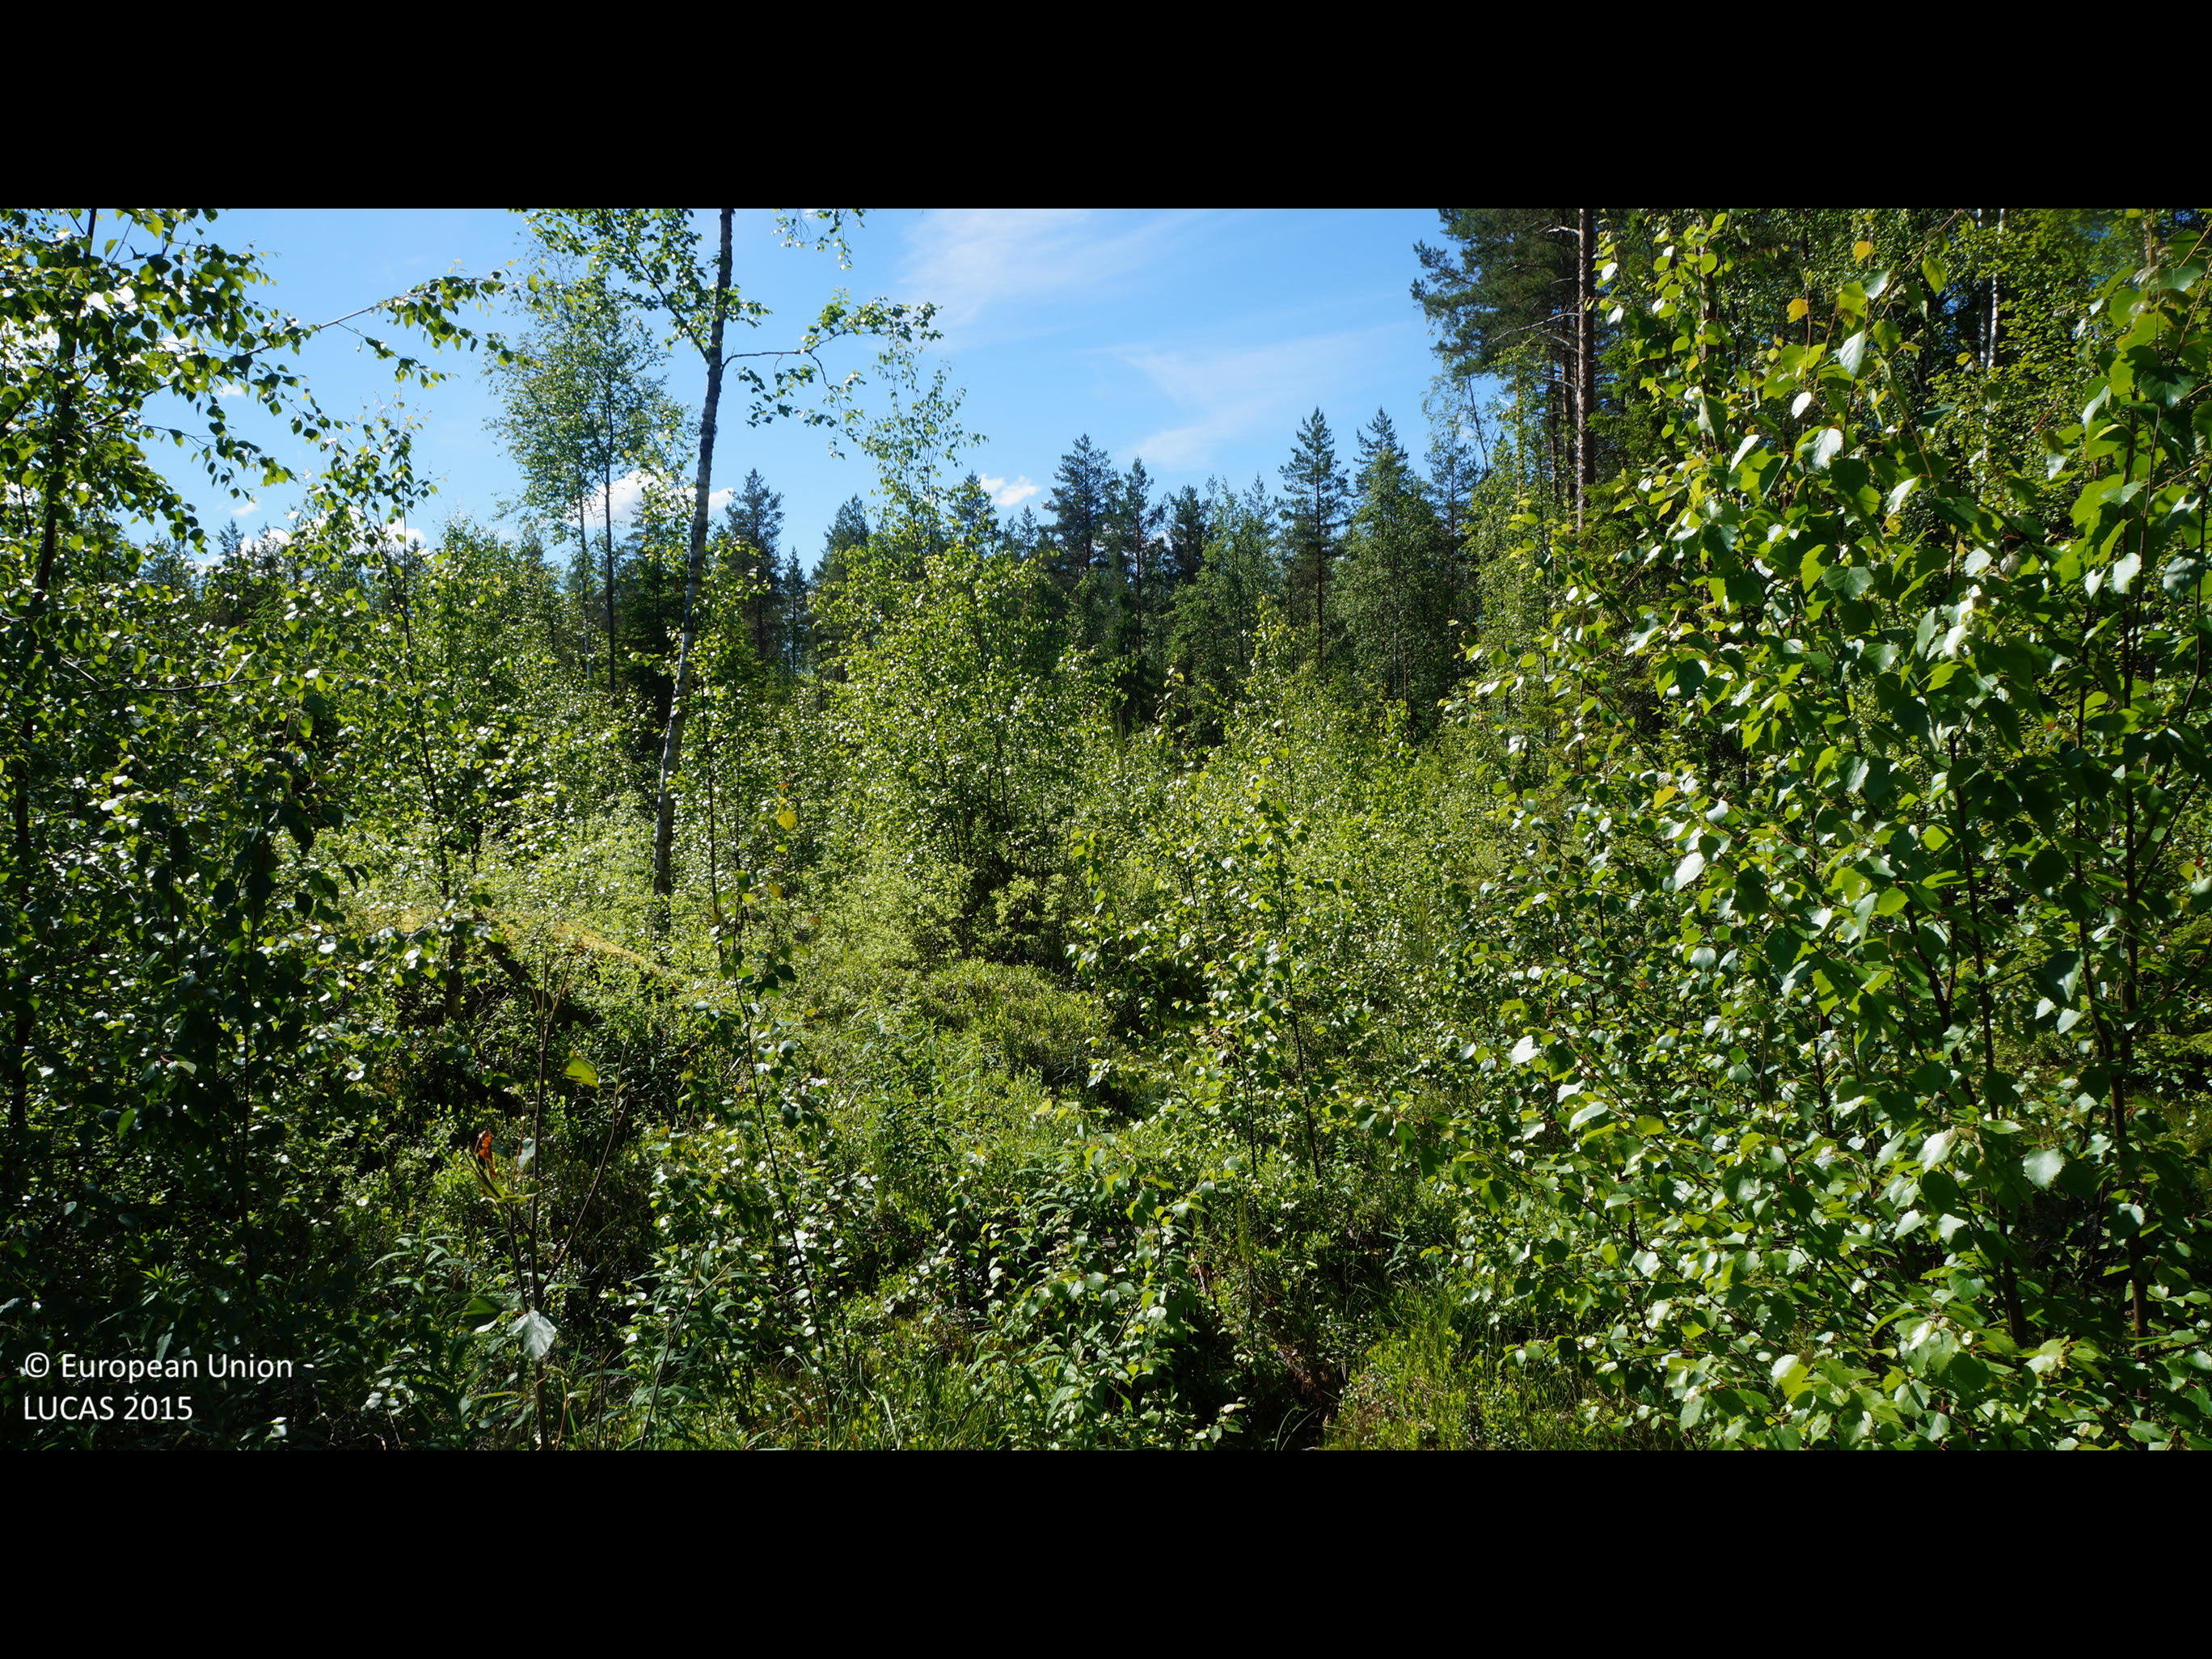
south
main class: Woodland
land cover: Broadleaved woodland
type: boreal forest
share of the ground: 50 - 75 %
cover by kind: broadleaved forest trees 40 %, shrubs 40 %, coniferous forest trees 10 %, herbaceous plants 5 %, unconsolidated bare surface 5 %
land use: Forestry
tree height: < 5 m
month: July
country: FI
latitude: 64.1516
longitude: 24.6930
